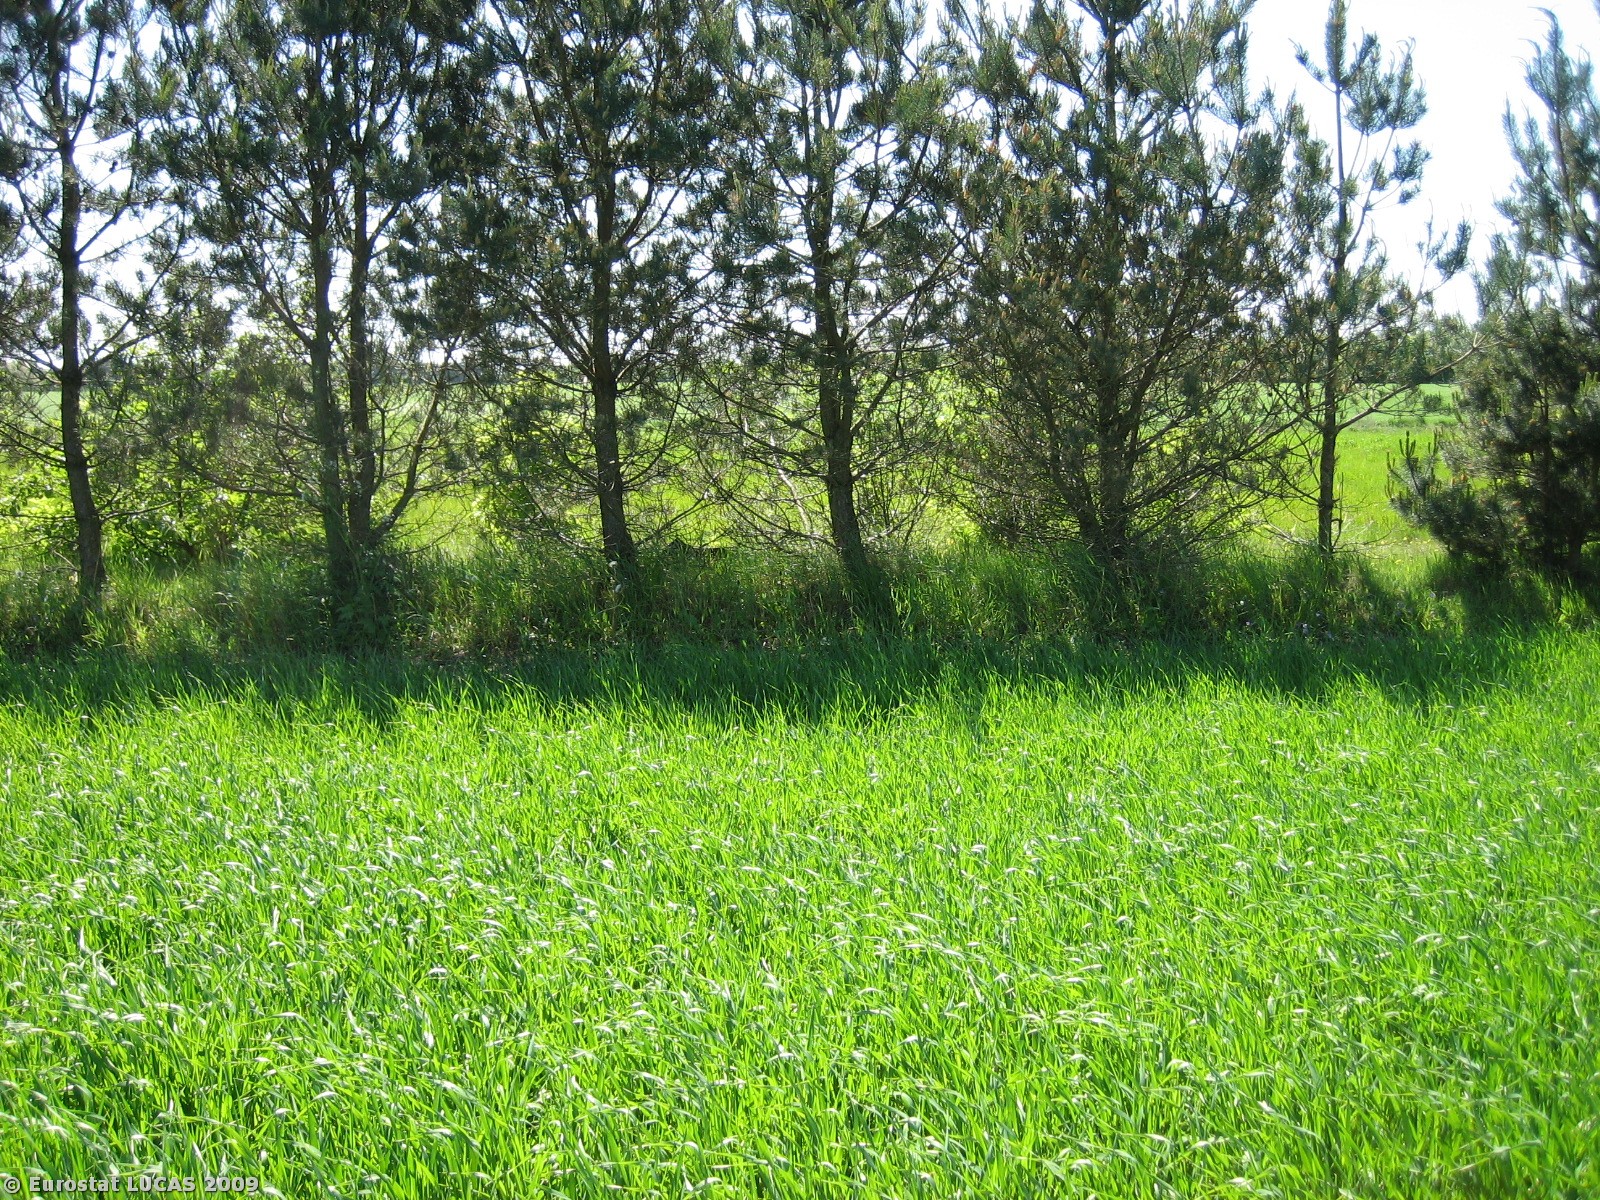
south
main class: Cropland
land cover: Barley
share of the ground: > 75 %
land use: Agriculture (excluding fallow land and kitchen gardens)
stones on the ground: < 10 %
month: May
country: DK
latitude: 55.9305
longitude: 8.8008
